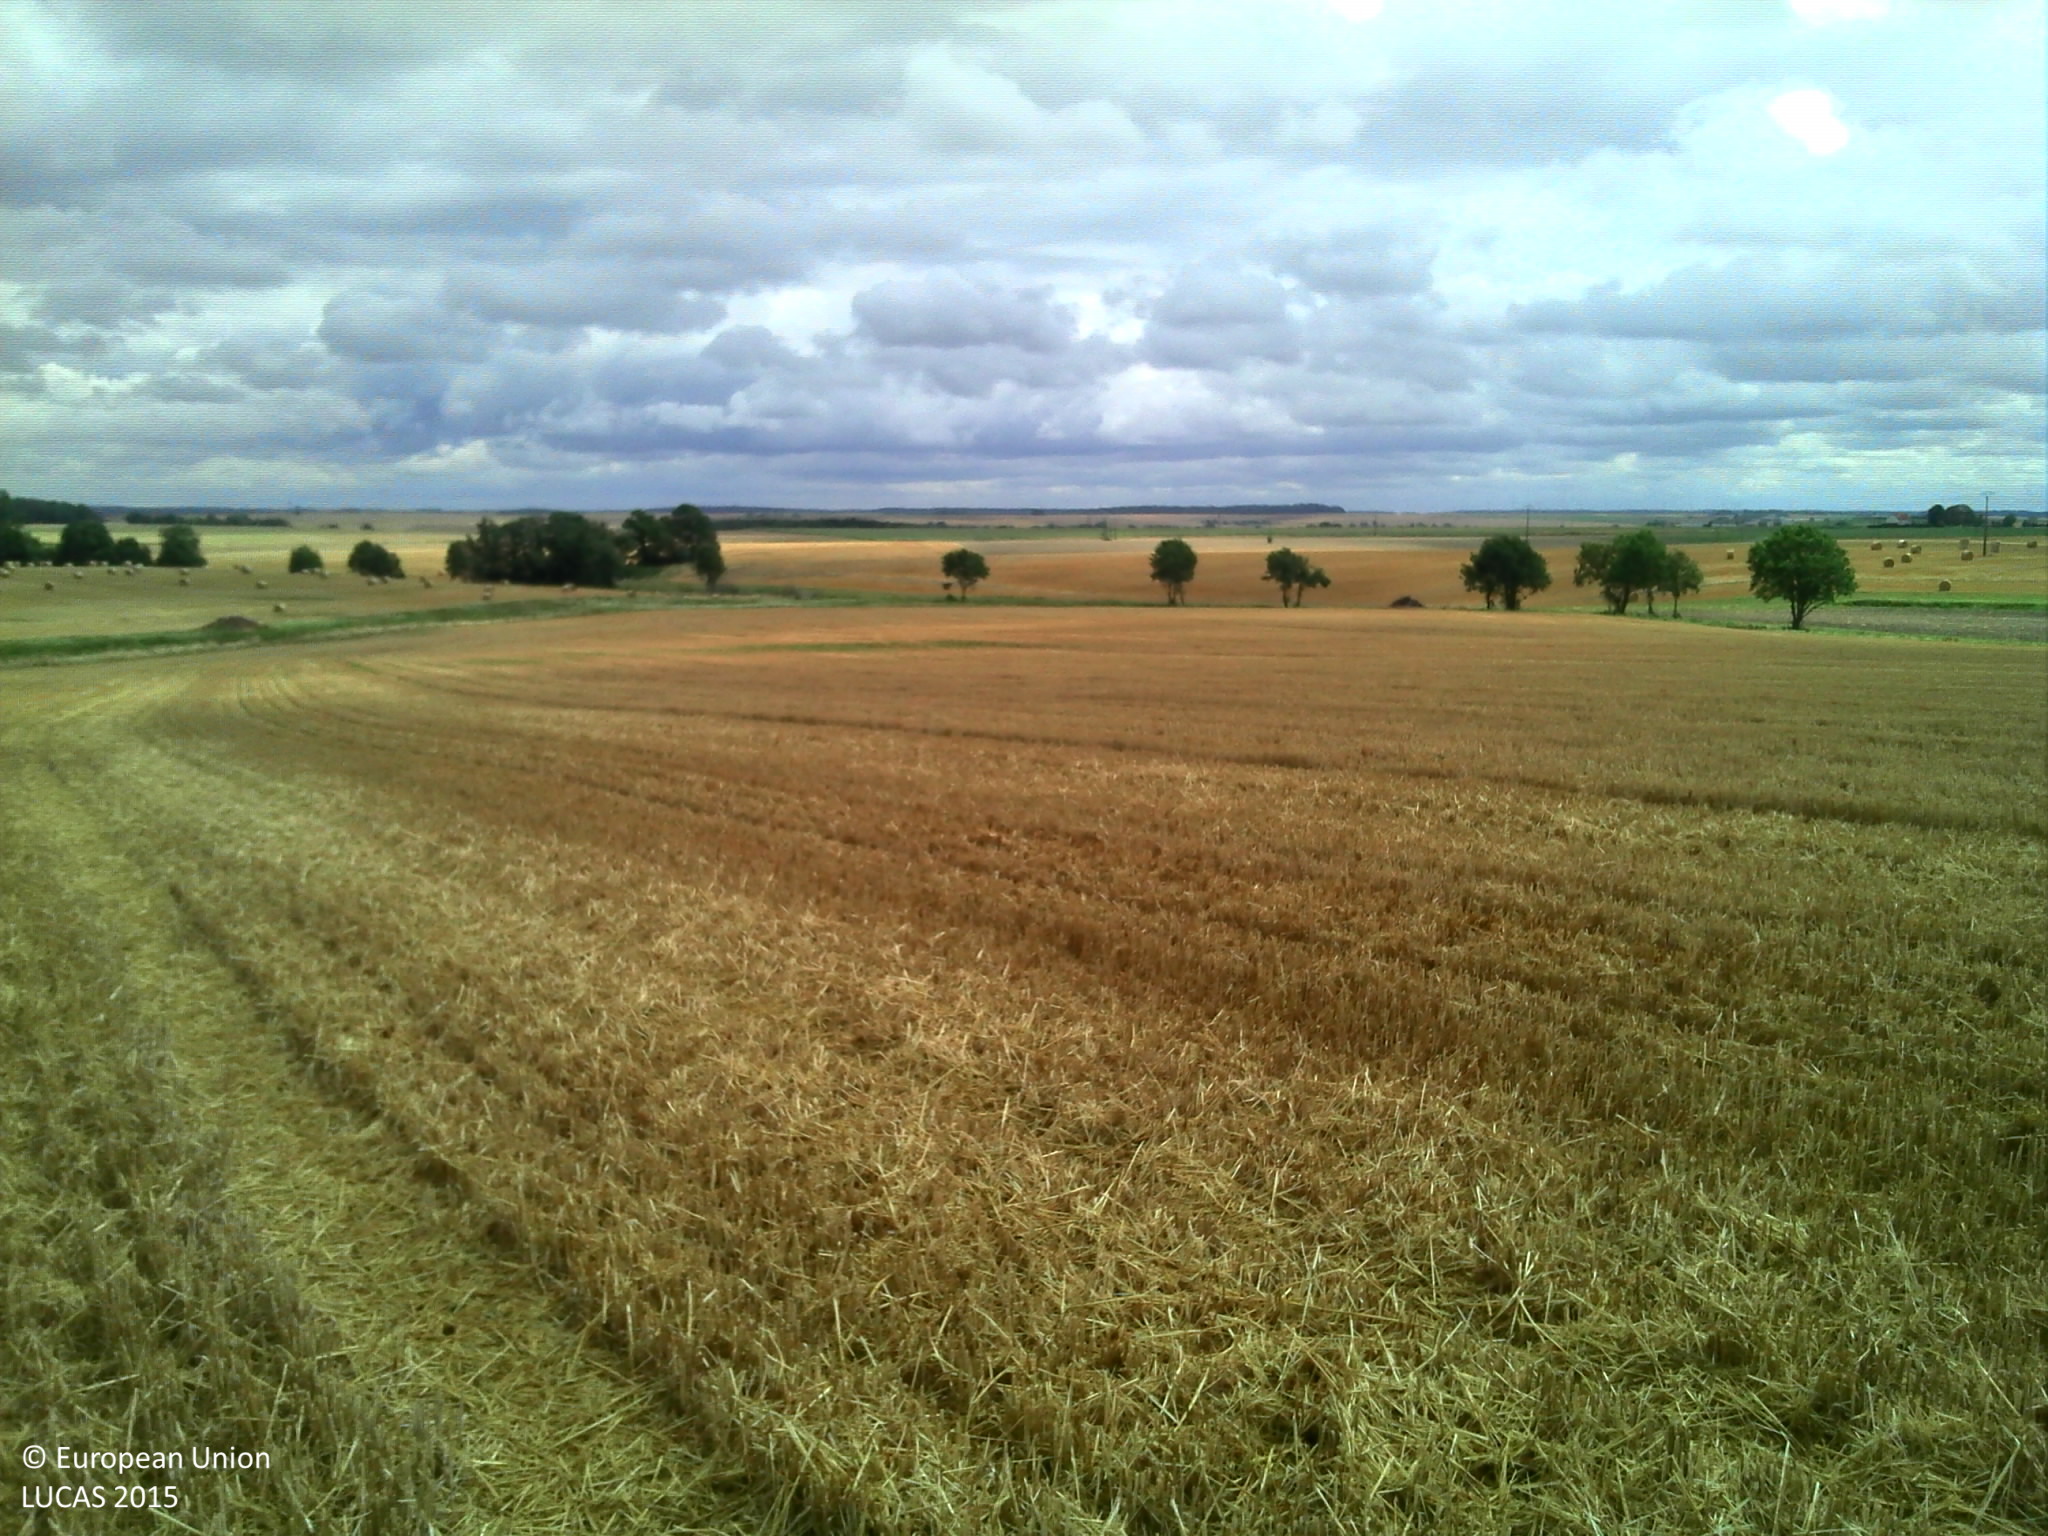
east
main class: Cropland
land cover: Common wheat
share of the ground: > 75 %
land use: Agriculture (excluding fallow land and kitchen gardens)
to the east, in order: Common wheat
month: July
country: FR
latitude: 49.1219
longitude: 5.0513
